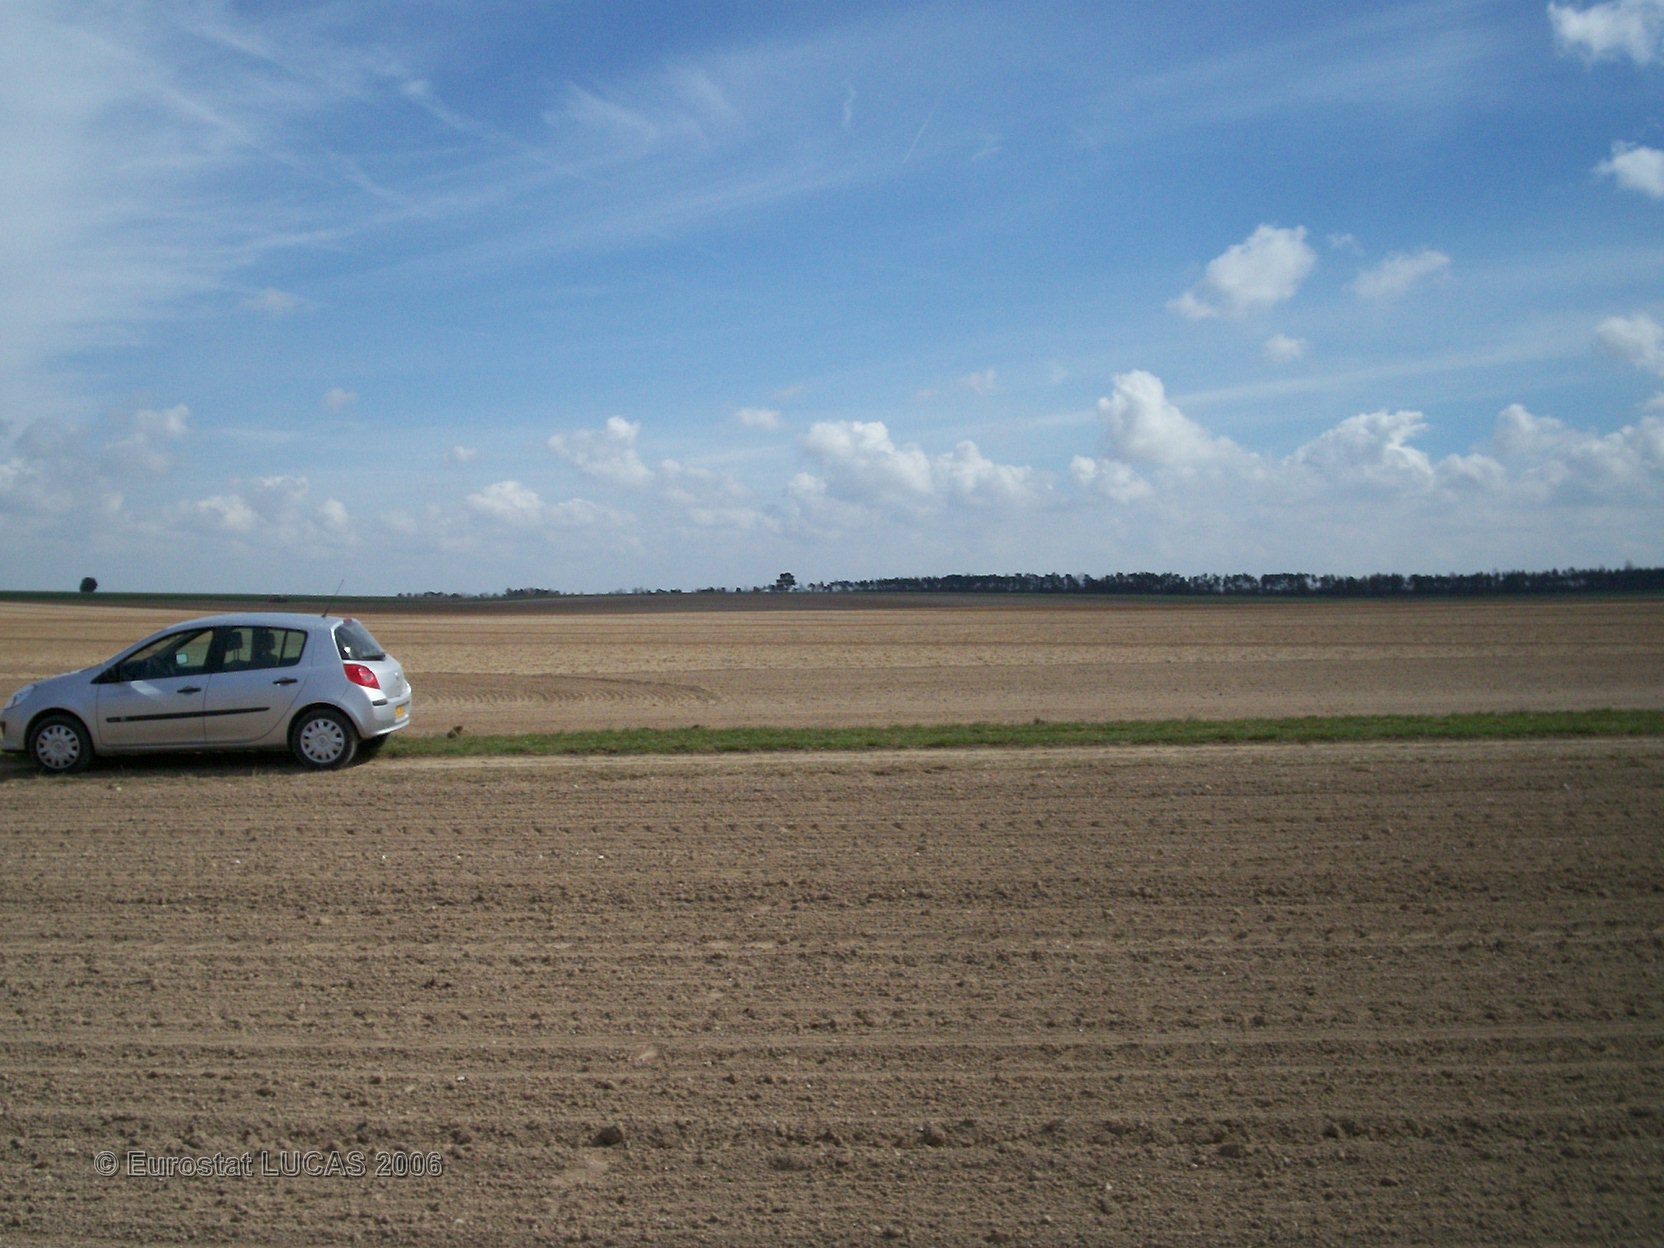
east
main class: Cropland
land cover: Sugar beet
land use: Agriculture (excluding fallow land and kitchen gardens)
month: June
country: FR
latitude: 49.1626
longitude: 4.3873
